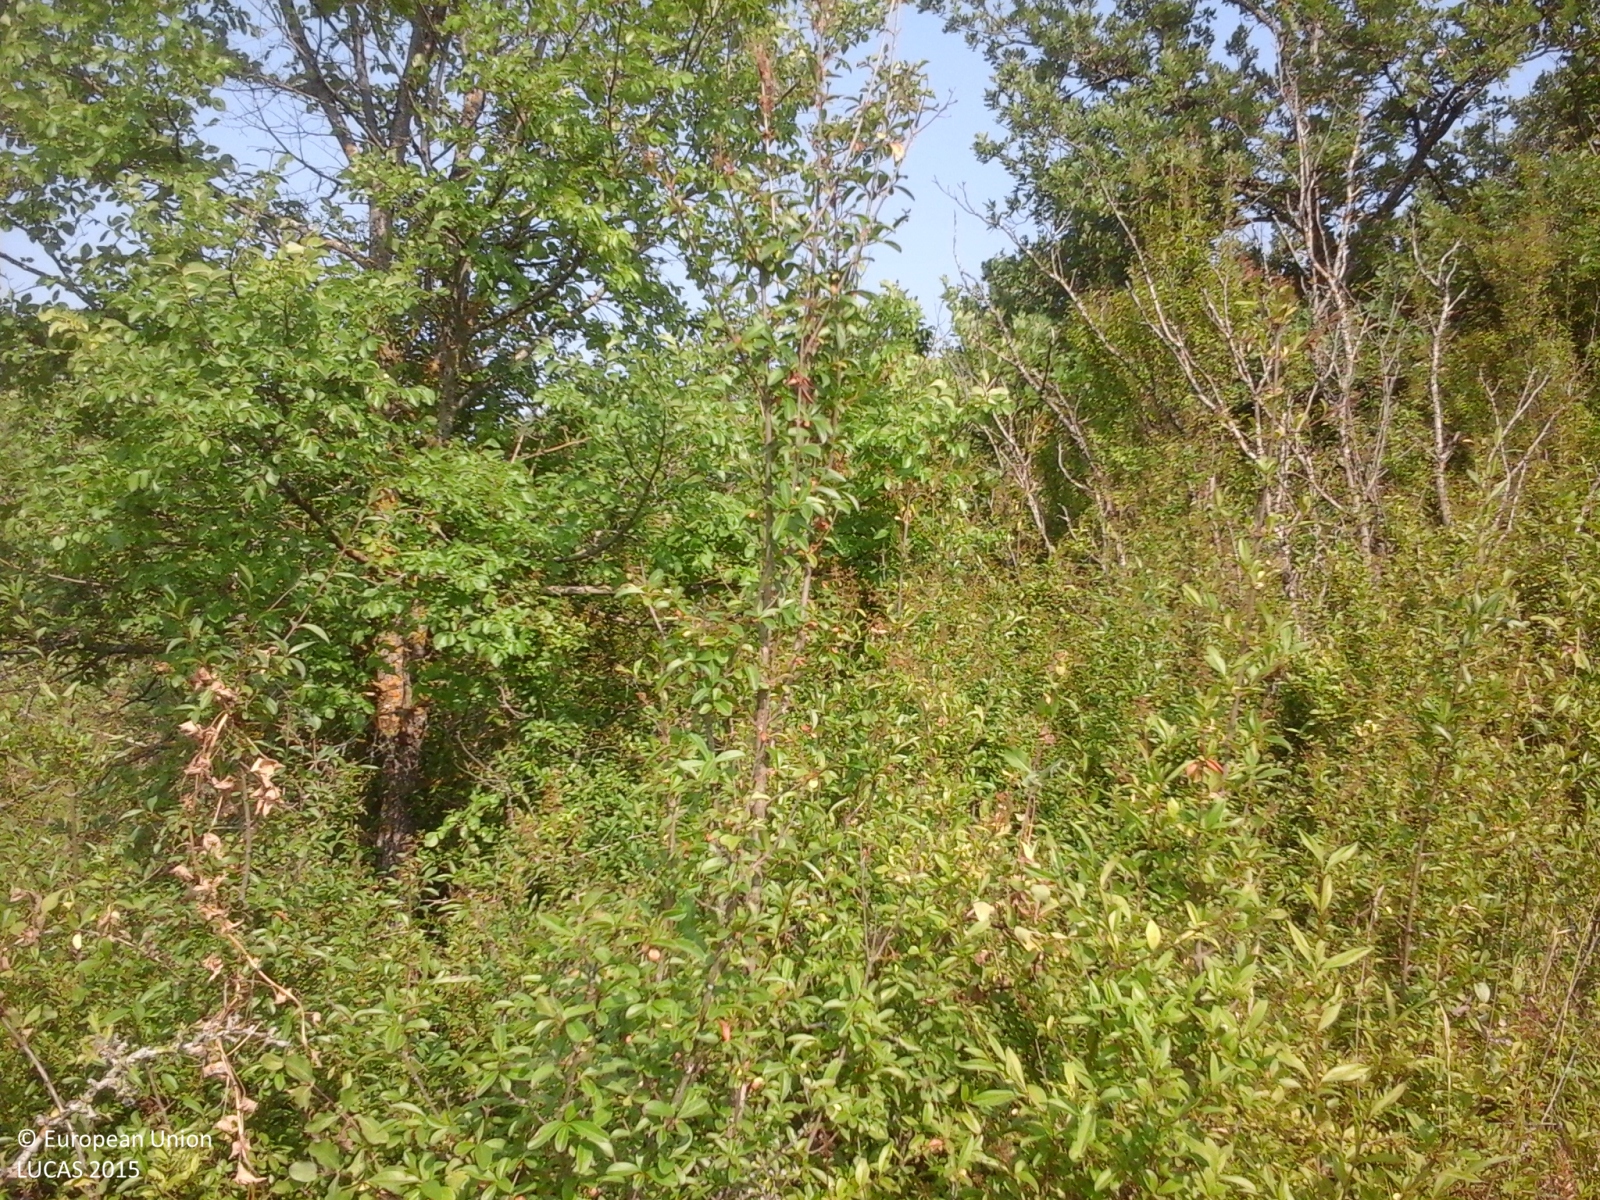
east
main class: Woodland
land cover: Broadleaved woodland
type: thermophilous deciduous forest
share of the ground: > 75 %
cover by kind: broadleaved forest trees 70 %, shrubs 25 %, herbaceous plants 5 %
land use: Forestry
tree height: > 5 m
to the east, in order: Broadleaved woodland
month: July
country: IT
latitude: 40.8974
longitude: 15.0725
